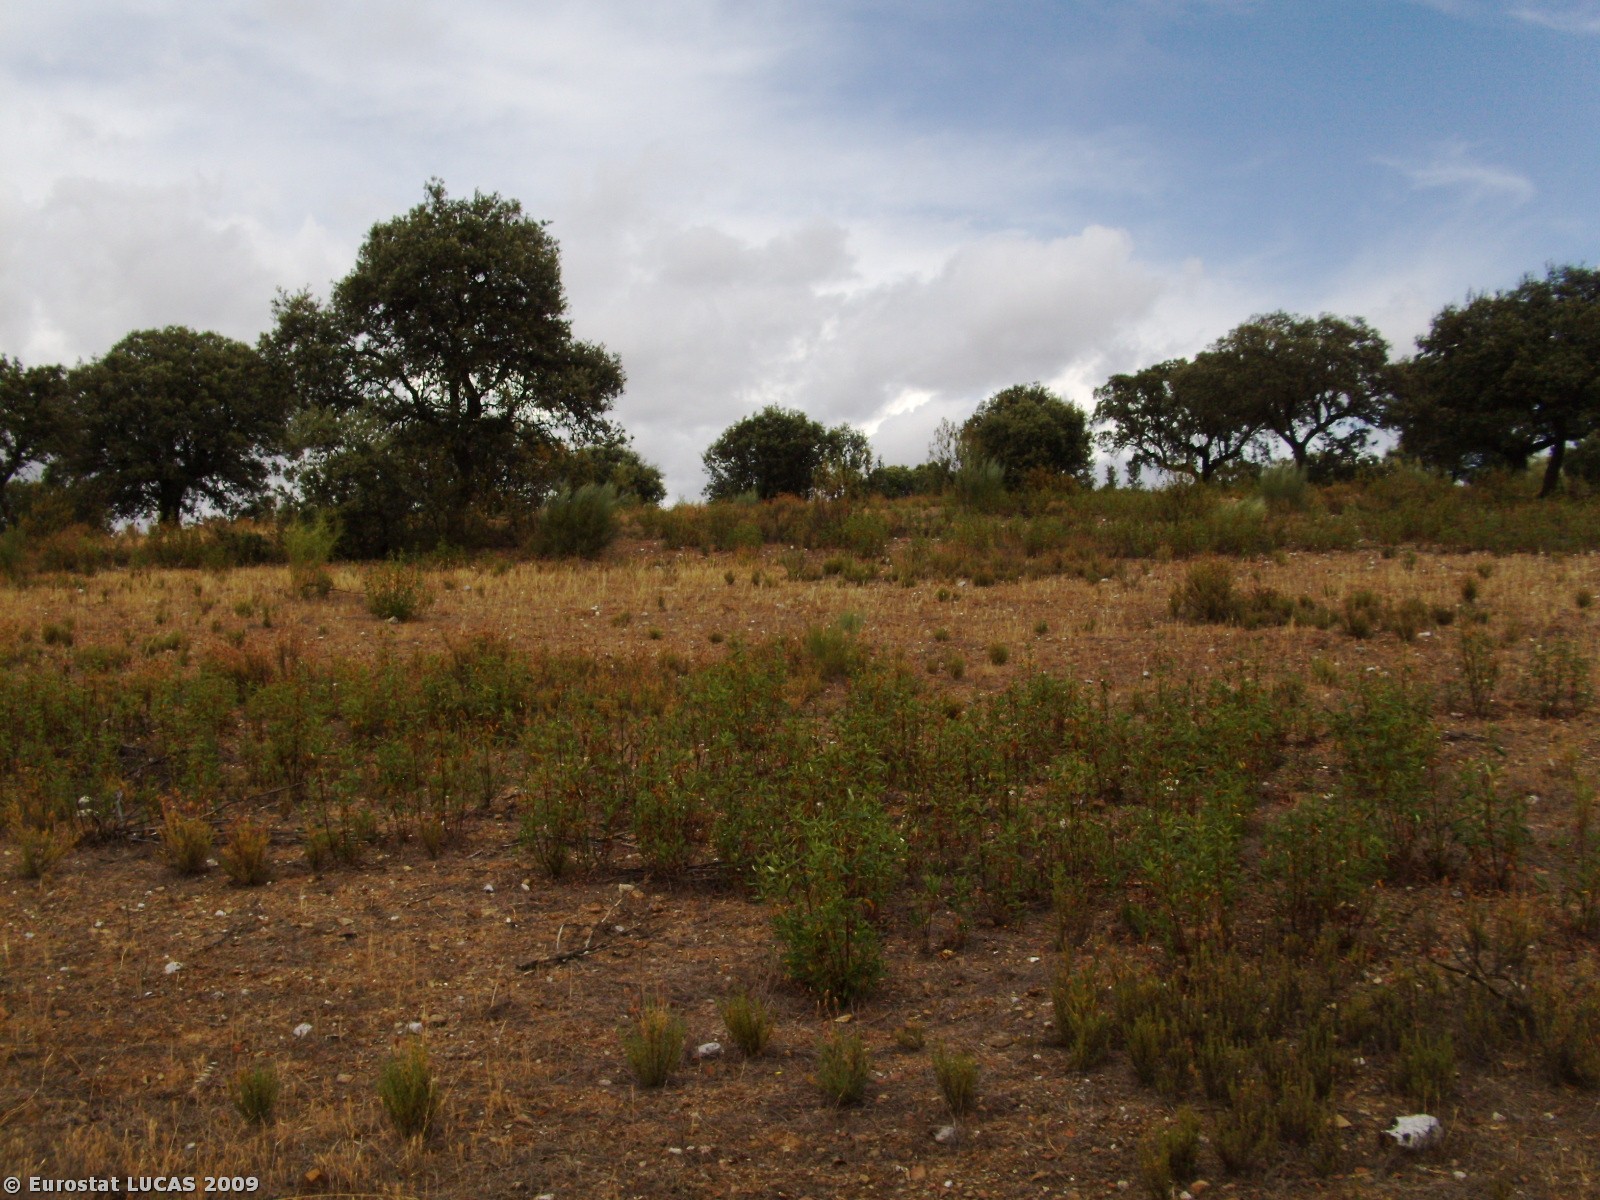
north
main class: Woodland
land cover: Broadleaved woodland
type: broadleaved evergreen forest
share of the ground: 25 - 50 %
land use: Forestry
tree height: > 5 m
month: June
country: PT
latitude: 39.7020
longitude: -7.0559
